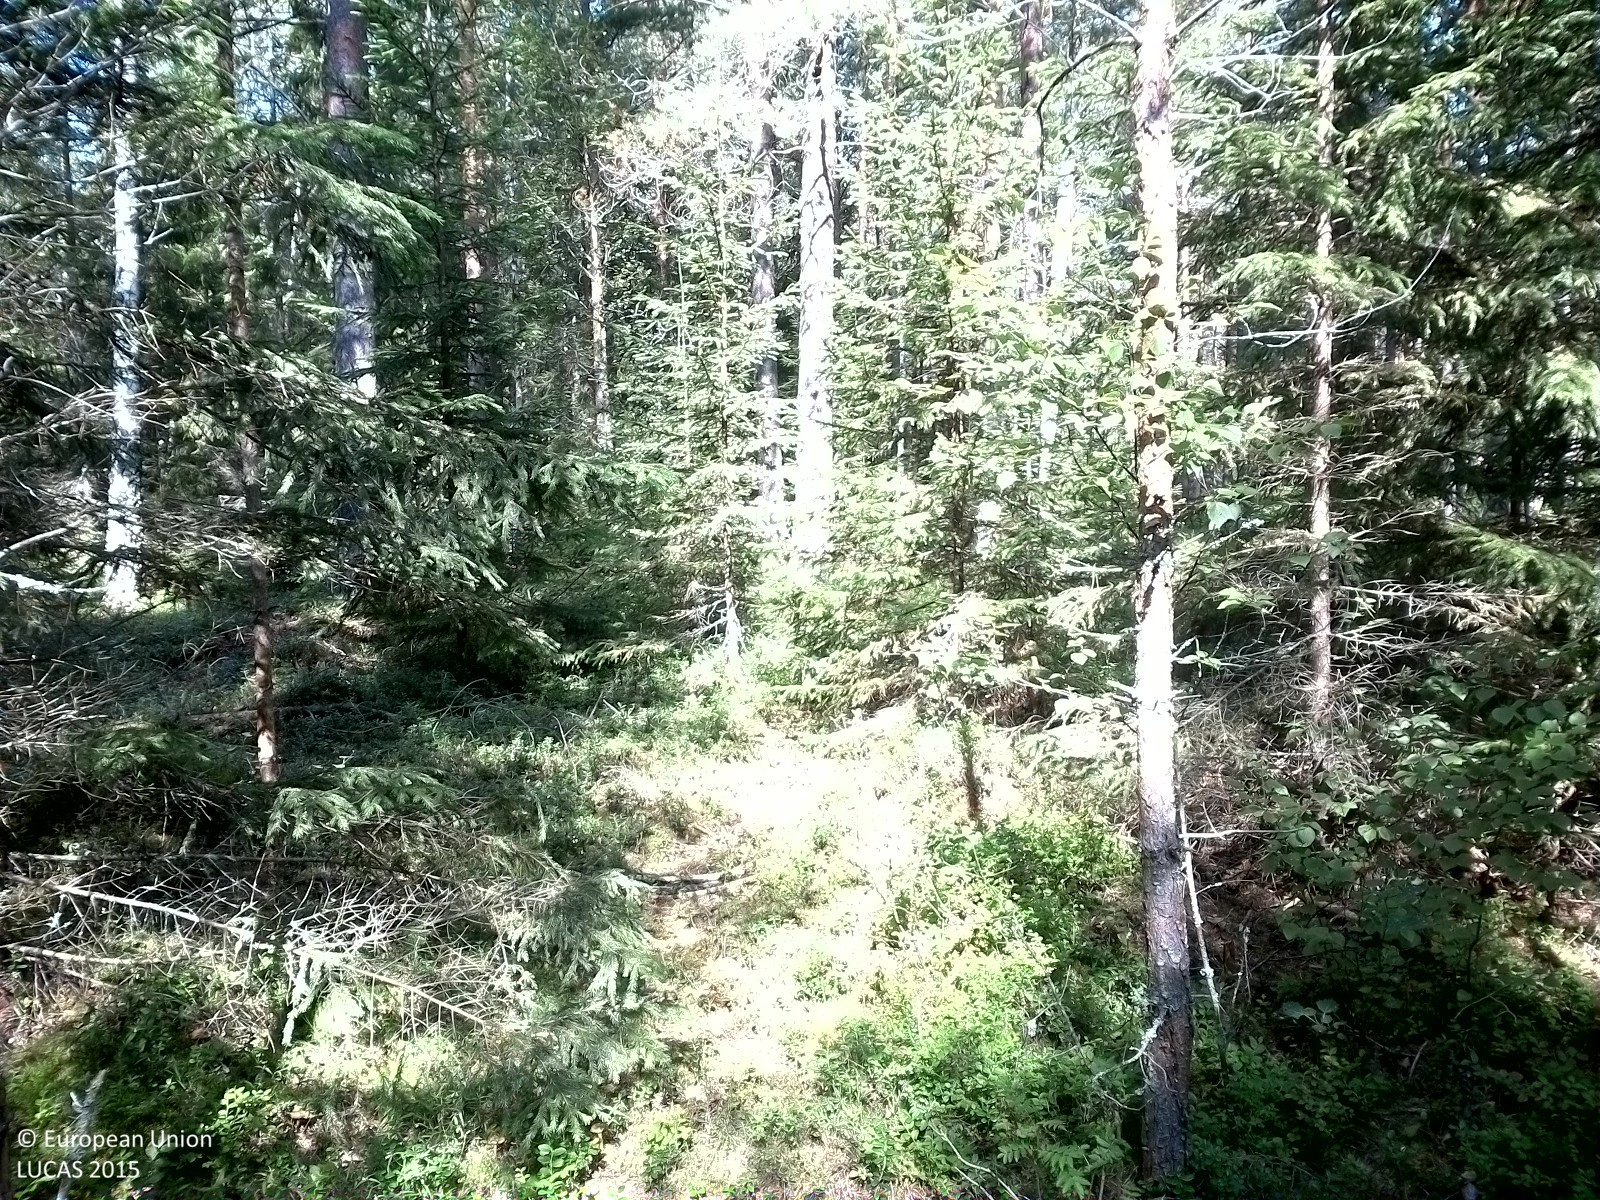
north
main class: Woodland
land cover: Other coniferous woodland
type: boreal forest
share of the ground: 50 - 75 %
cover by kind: coniferous forest trees 60 %, herbaceous plants 30 %, broadleaved forest trees 5 %, lichens and mosses 5 %
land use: Forestry
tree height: < 5 m
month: August
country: SE
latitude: 59.1474
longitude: 15.1842
